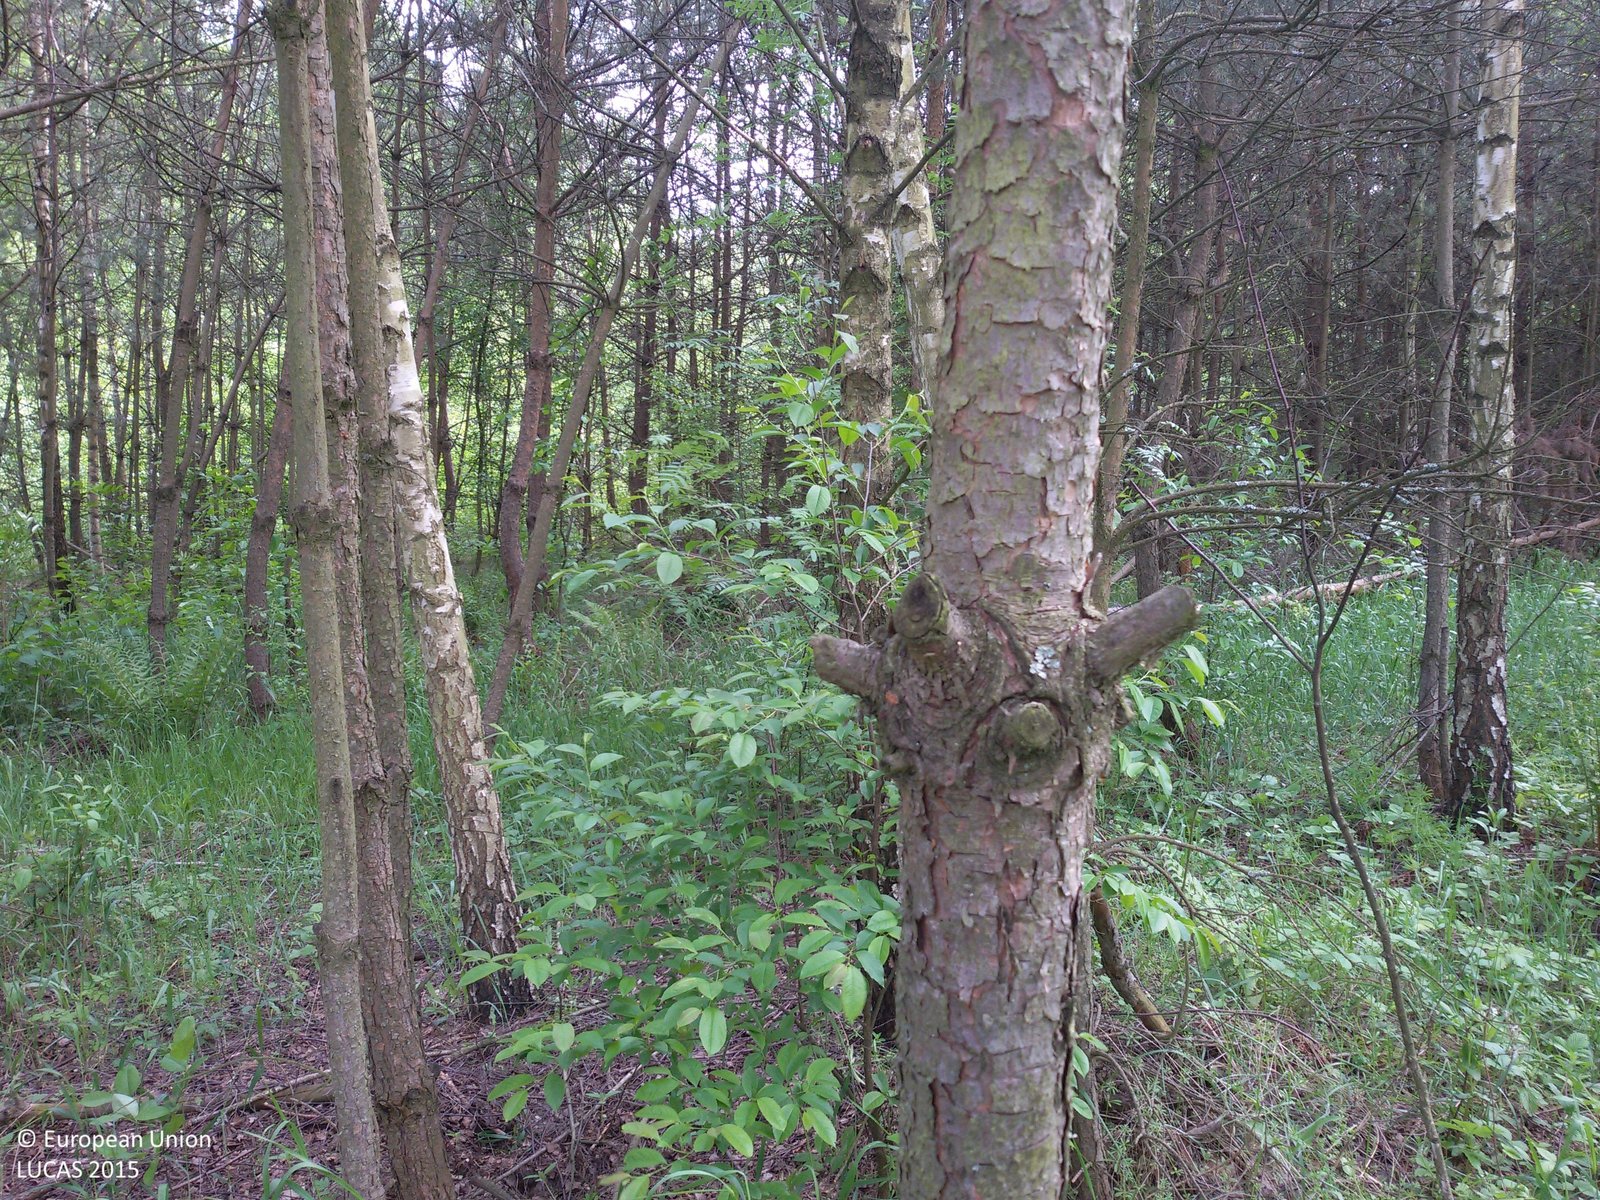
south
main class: Woodland
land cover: Pine dominated mixed woodland
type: hemiboreal forest and nemoral coniferous forest and mixed broadleaved-coniferous forest
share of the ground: > 75 %
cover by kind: coniferous forest trees 45 %, broadleaved forest trees 30 %, herbaceous plants 20 %, shrubs 5 %
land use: Forestry
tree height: > 5 m
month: May
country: PL
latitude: 51.8905
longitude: 20.7207
